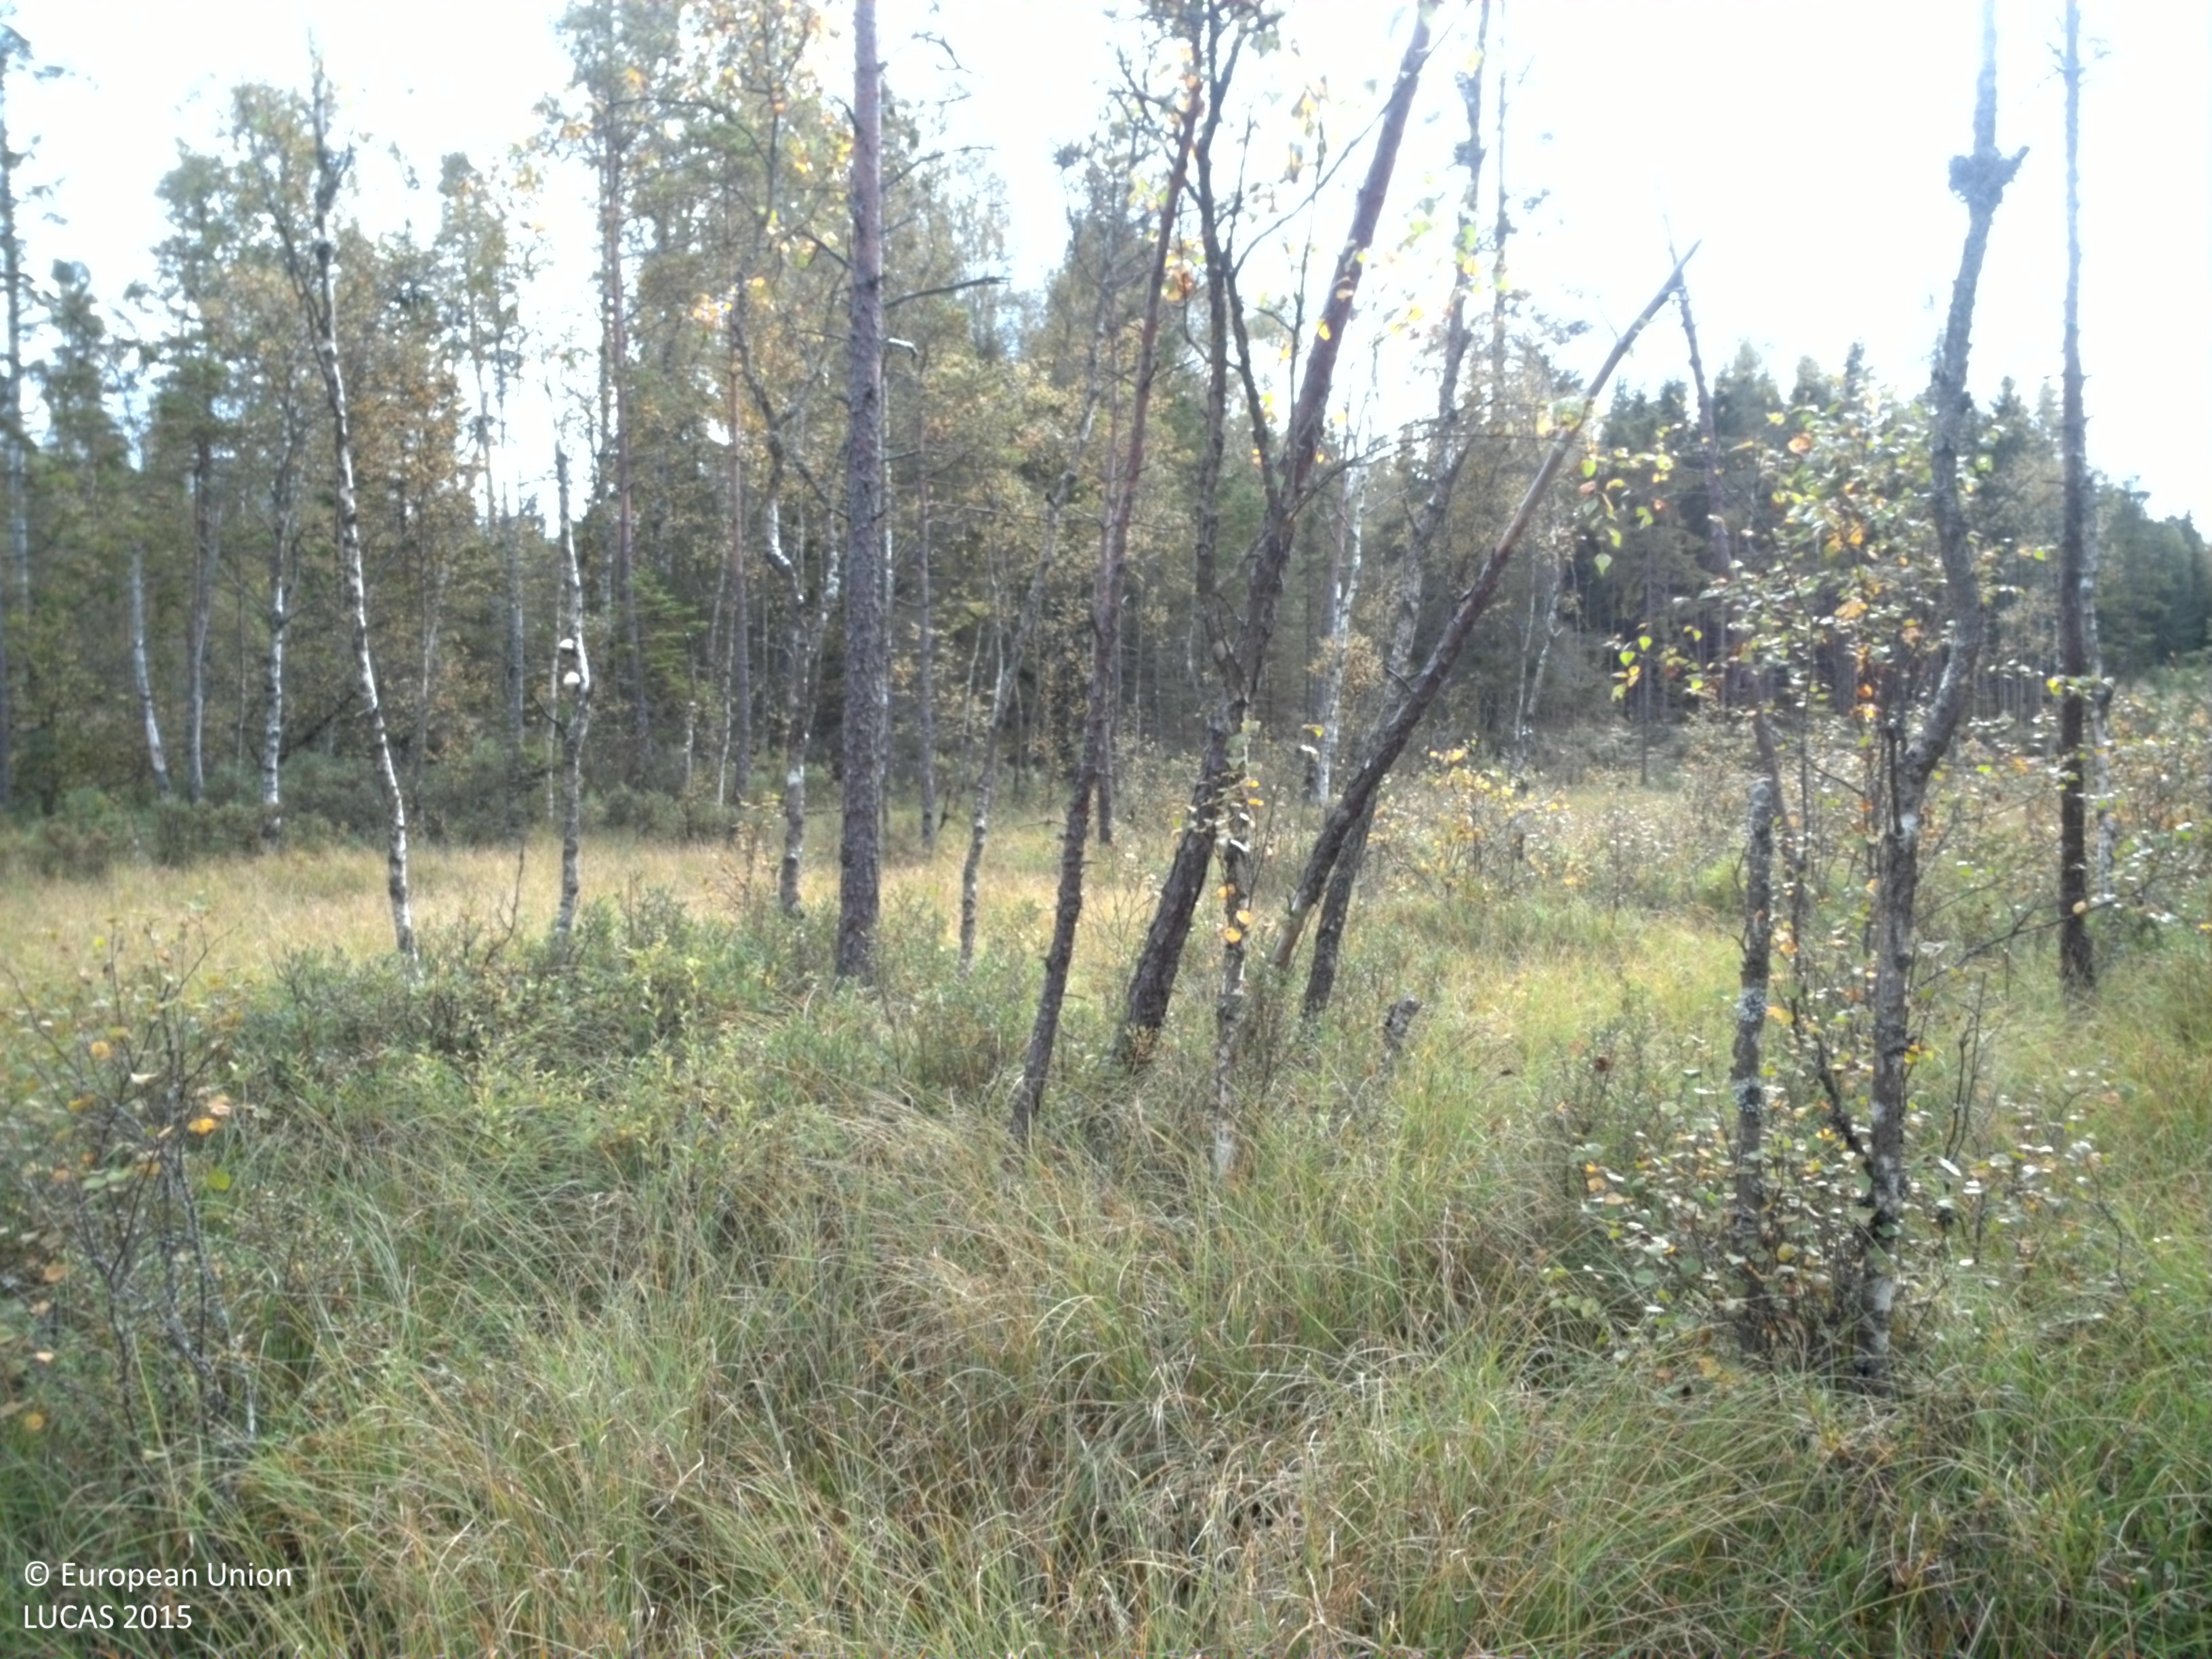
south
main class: Woodland
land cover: Pine dominated mixed woodland
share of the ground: 10 - 25 %
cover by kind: herbaceous plants 70 %, coniferous forest trees 10 %, lichens and mosses 10 %, broadleaved forest trees 5 %, shrubs 5 %
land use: Semi-natural and natural areas not in use
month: September
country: SE
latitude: 58.0235
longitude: 13.0256
